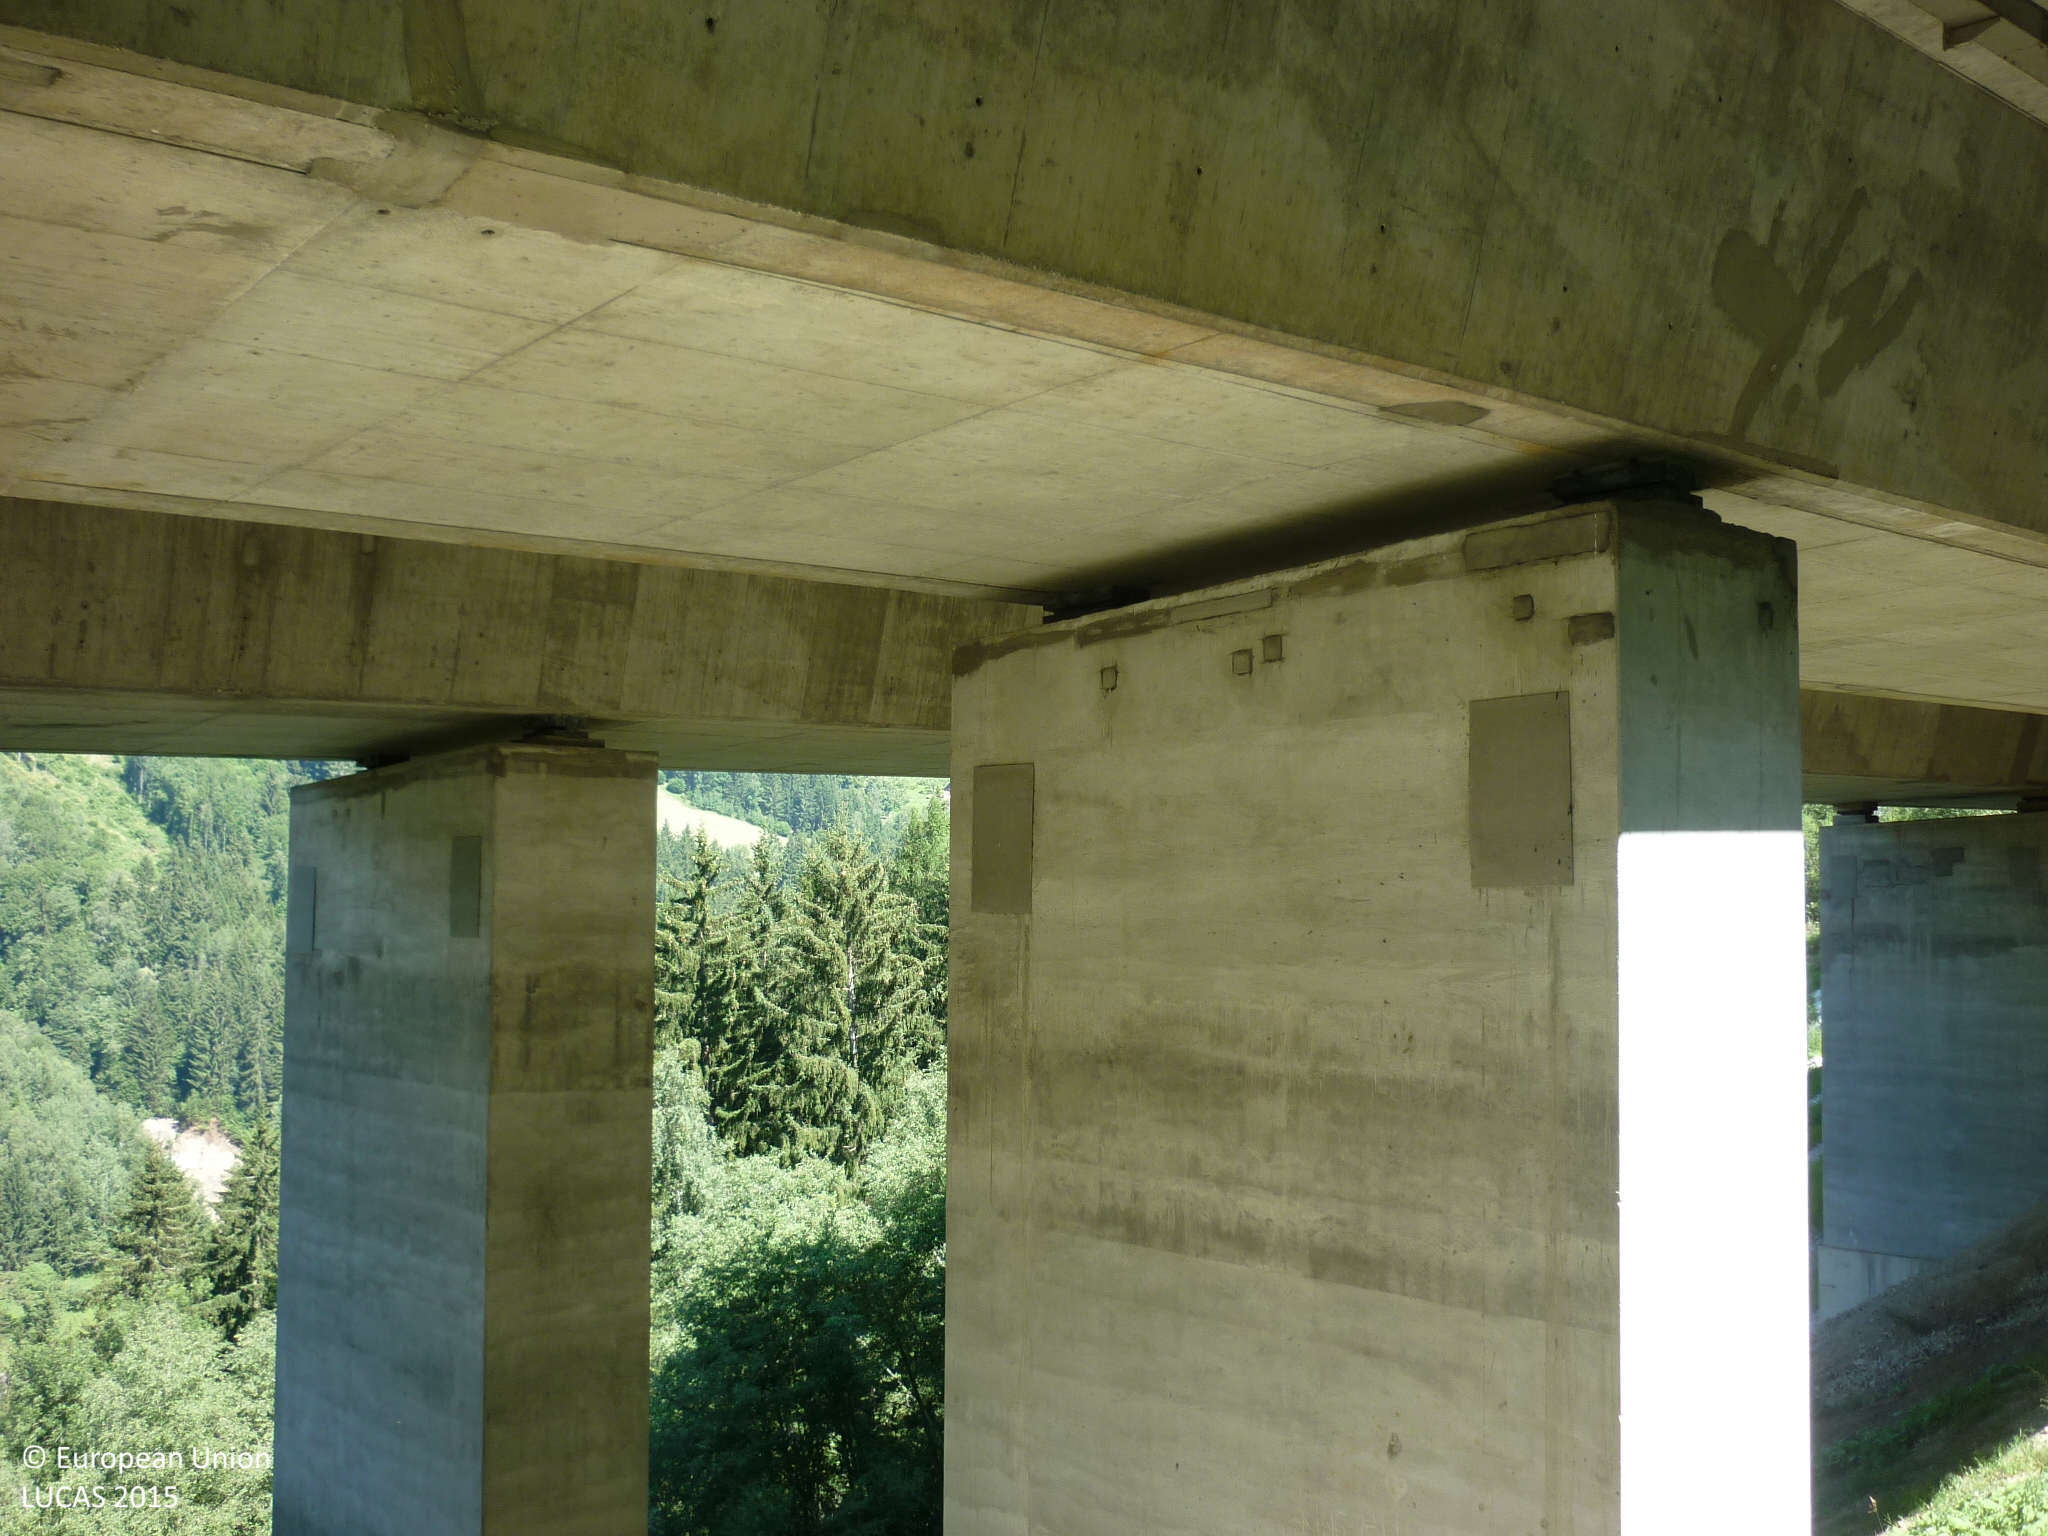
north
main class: Grassland
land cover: Grassland without tree/shrub cover
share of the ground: > 75 %
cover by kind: herbaceous plants 100 %
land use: Road transport
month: August
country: AT
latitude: 46.9222
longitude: 13.5827
